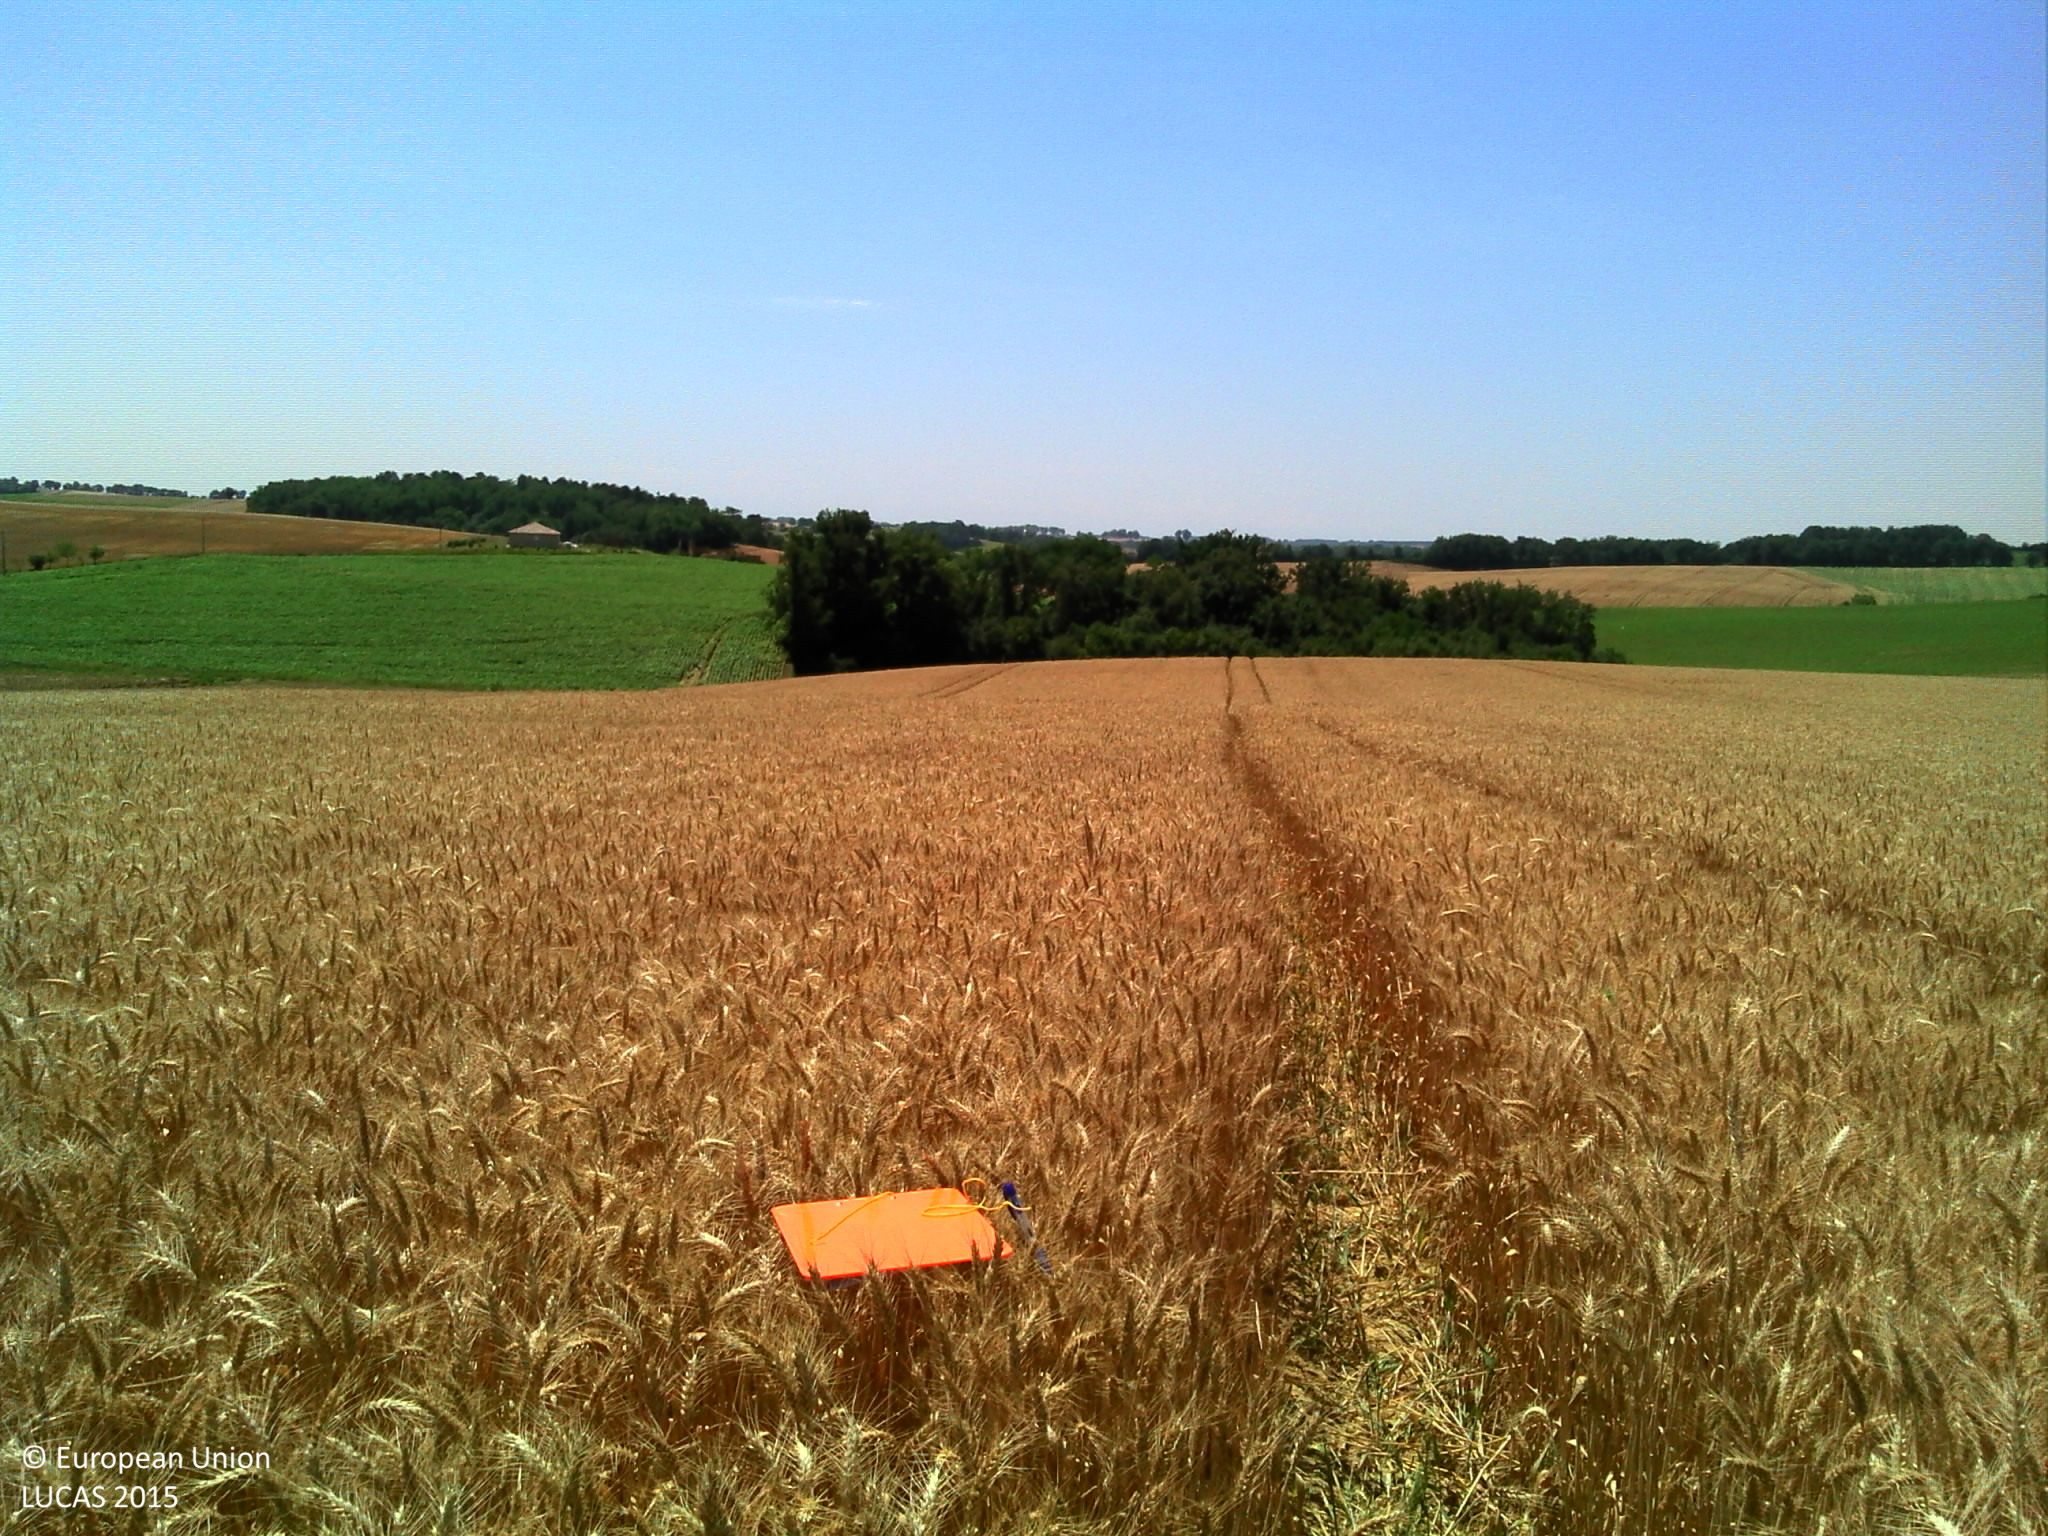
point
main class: Cropland
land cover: Common wheat
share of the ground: > 75 %
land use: Agriculture (excluding fallow land and kitchen gardens)
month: June
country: FR
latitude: 43.7745
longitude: 0.9670
